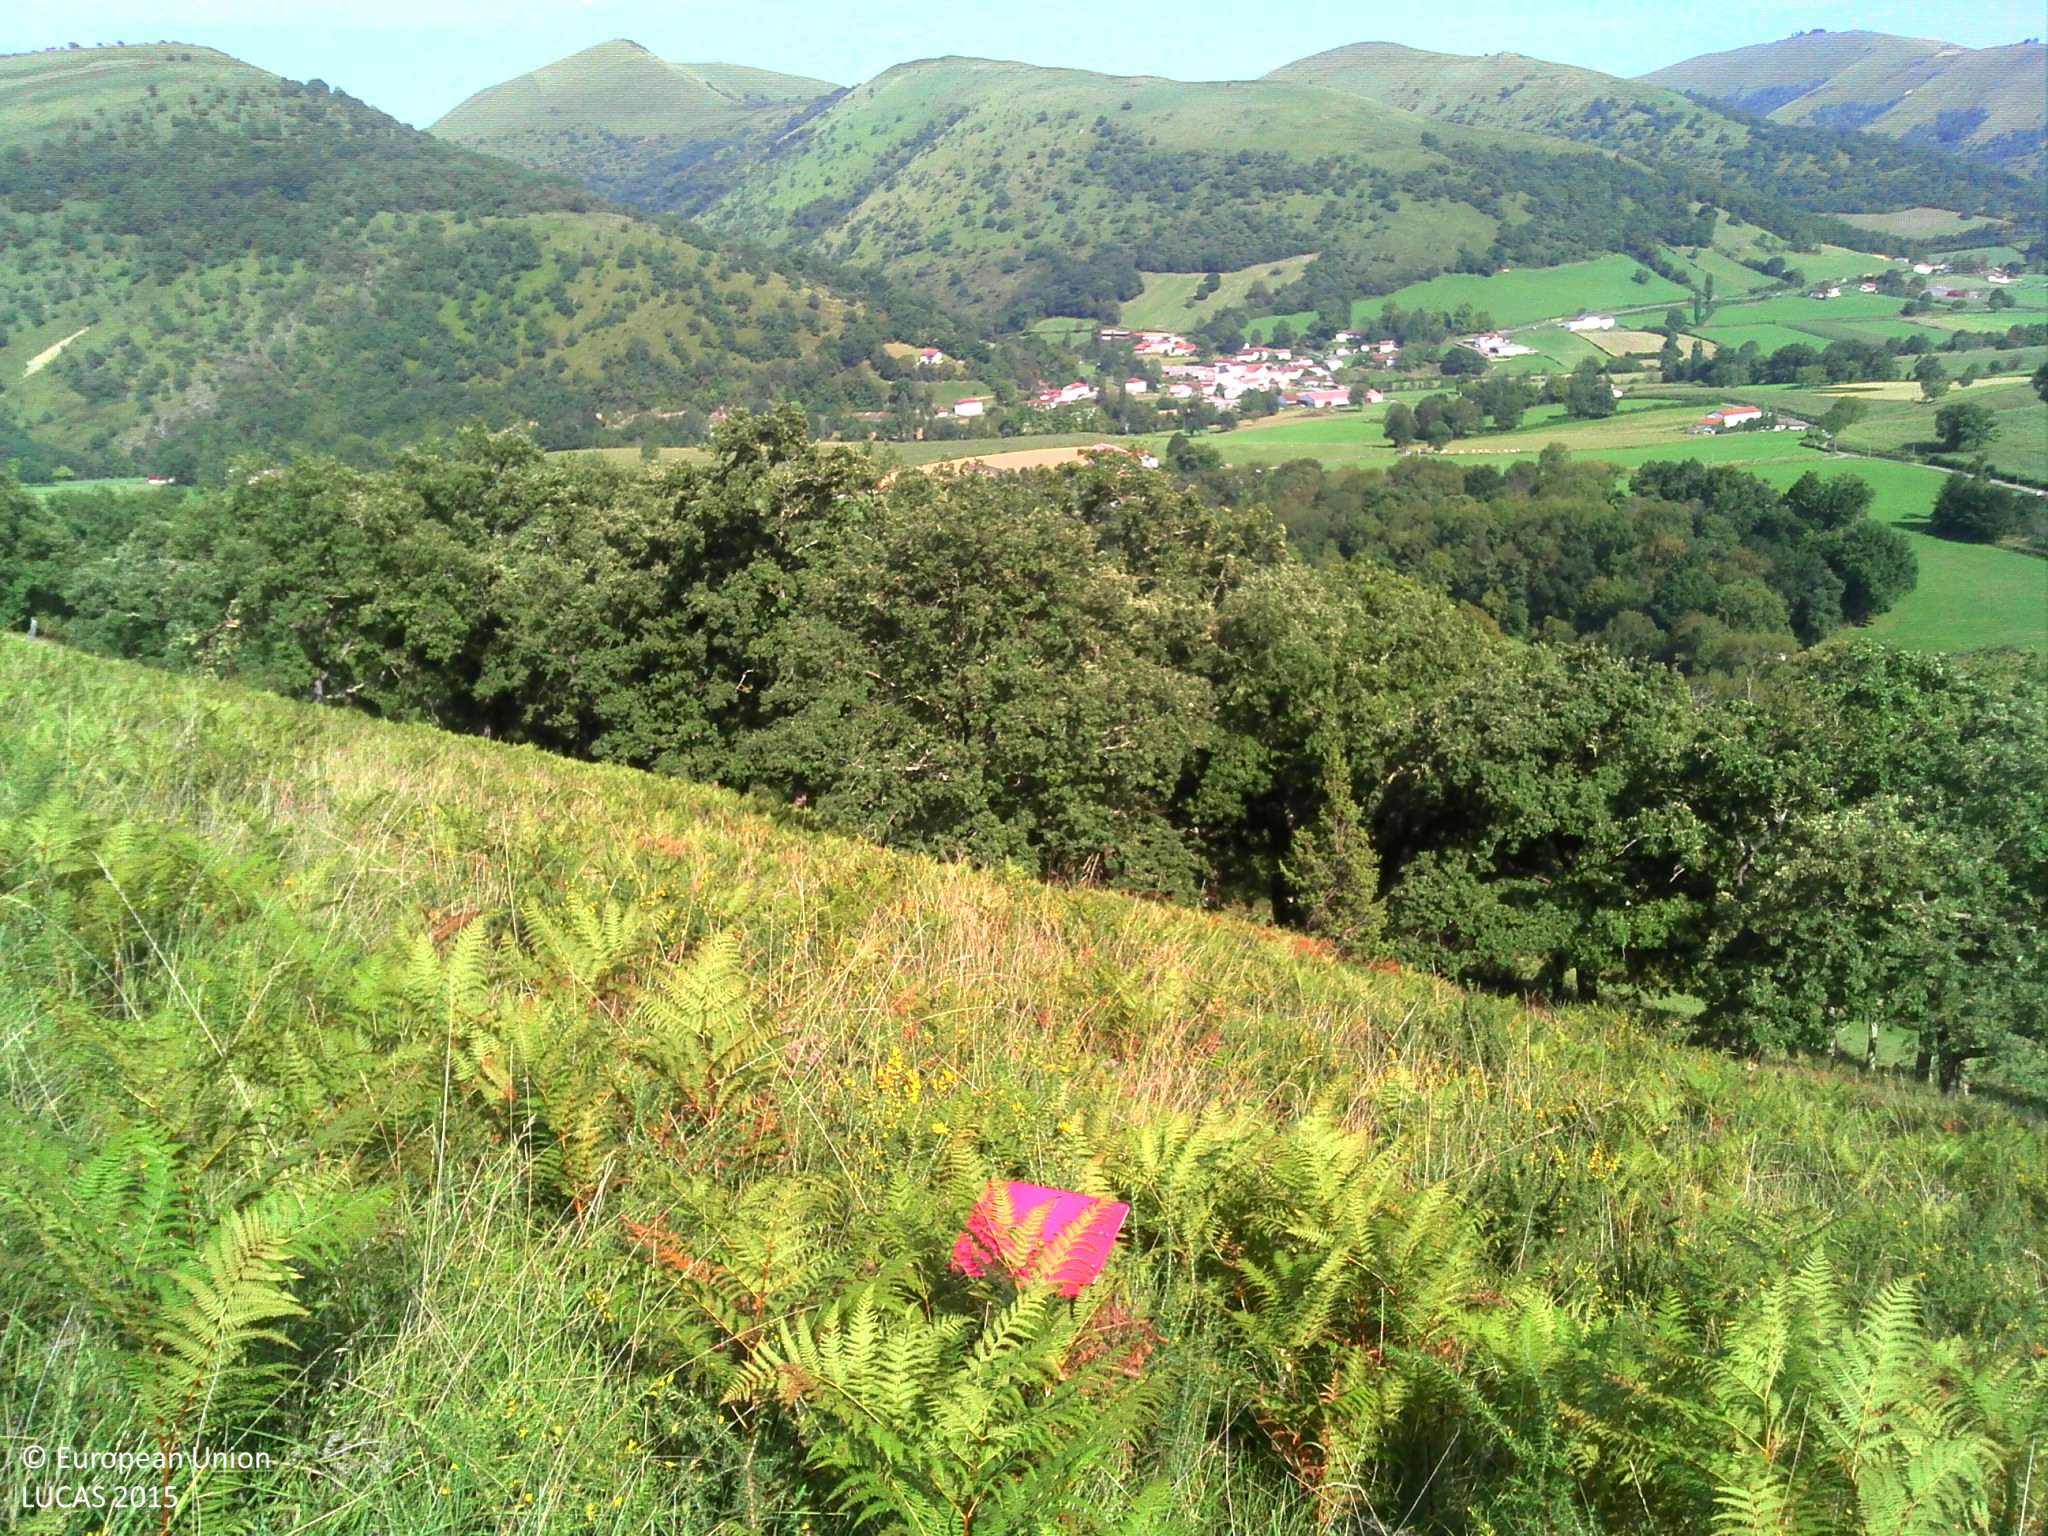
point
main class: Grassland
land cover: Grassland without tree/shrub cover
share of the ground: > 75 %
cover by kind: herbaceous plants 90 %, shrubs 5 %, consolidated bare surface 5 %
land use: Agriculture (excluding fallow land and kitchen gardens)
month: September
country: FR
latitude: 43.1919
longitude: -1.0743
